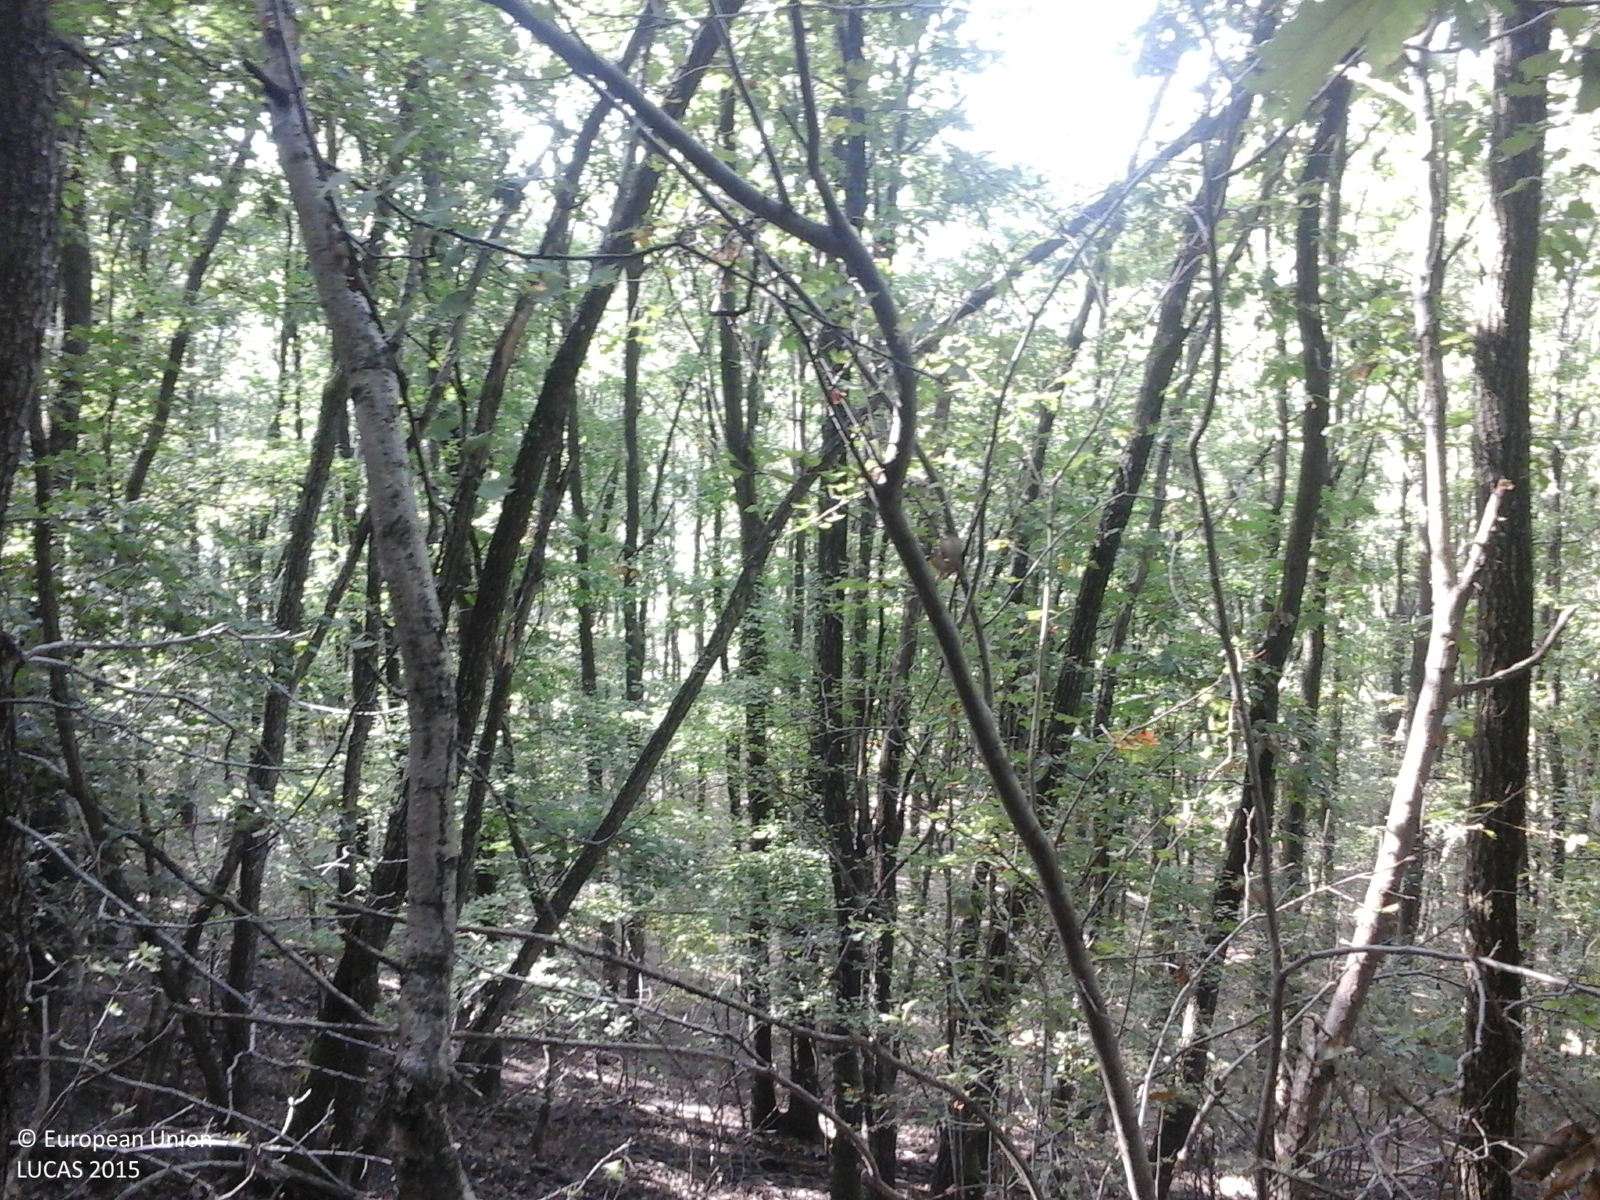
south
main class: Woodland
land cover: Broadleaved woodland
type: acidophilous oak and oak-birch forest
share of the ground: > 75 %
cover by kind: broadleaved forest trees 100 %
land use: Forestry
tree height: > 5 m
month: September
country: RO
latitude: 47.0883
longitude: 23.7090
